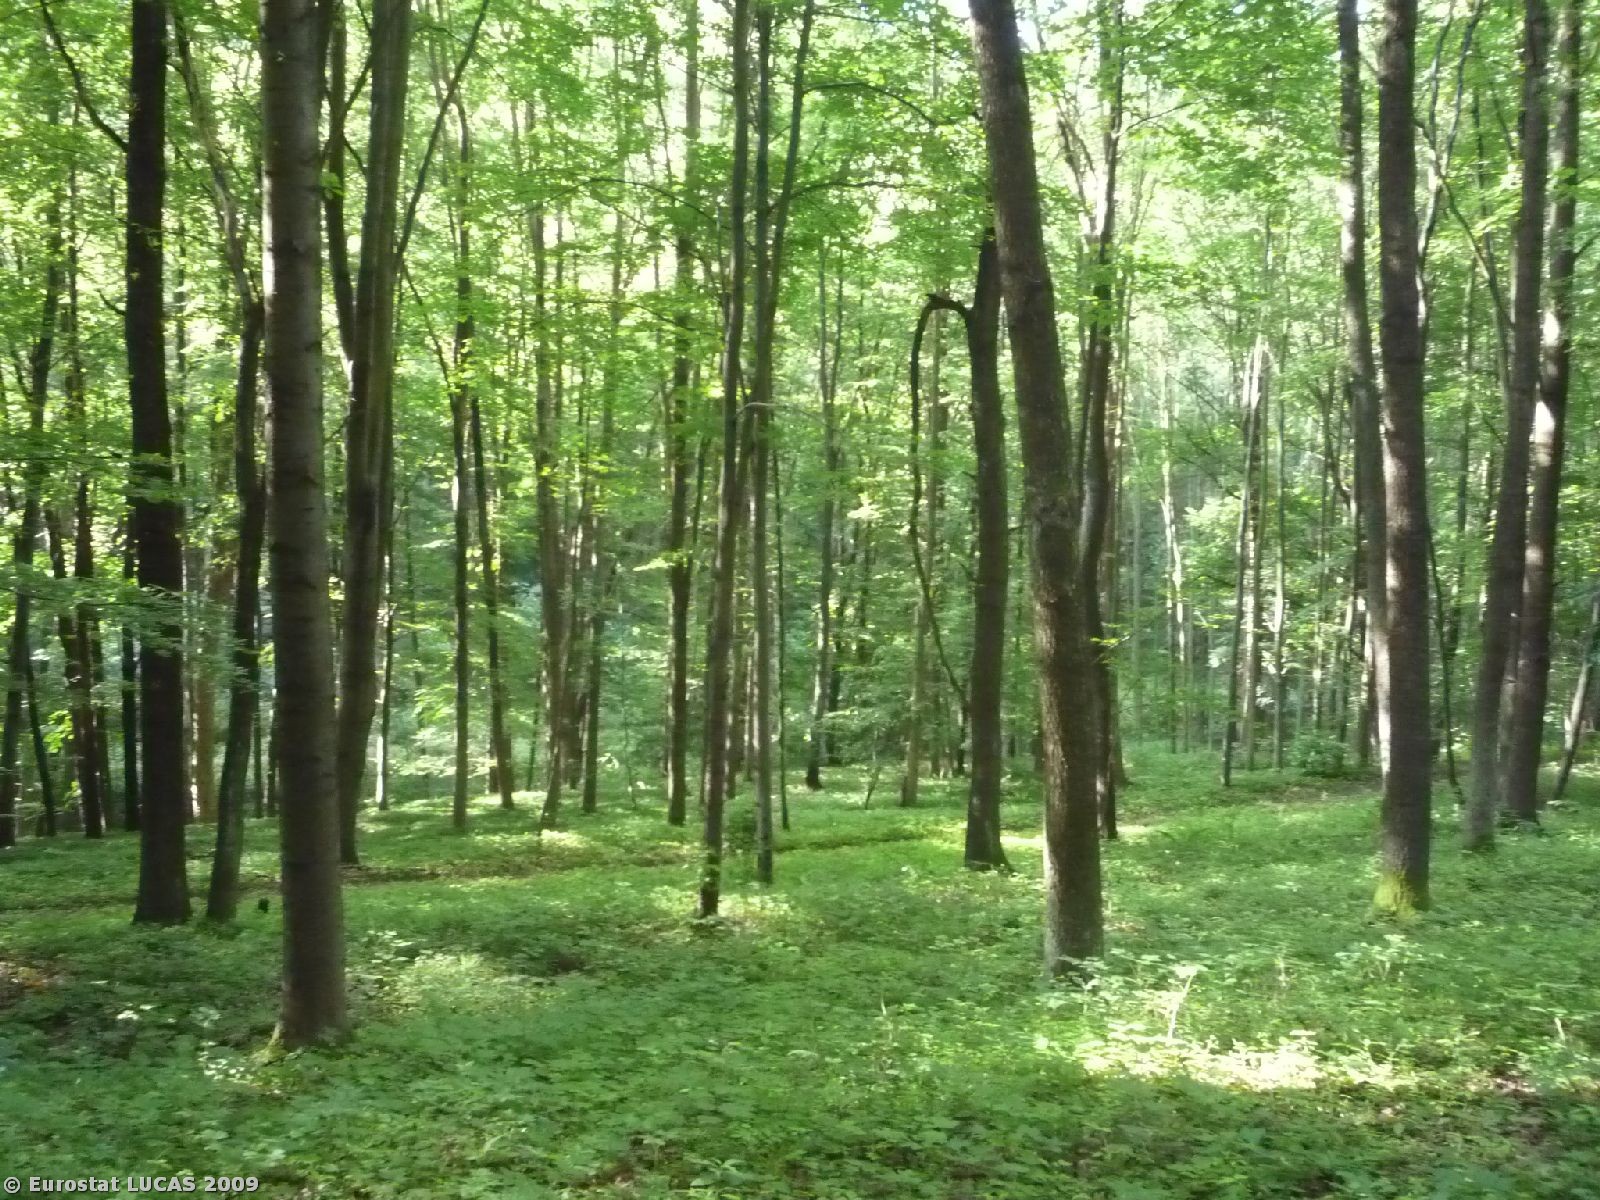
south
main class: Woodland
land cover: Broadleaved woodland
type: beech forest
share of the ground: > 75 %
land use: Forestry
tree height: > 5 m
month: June
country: CZ
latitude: 50.4489
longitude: 15.4824
